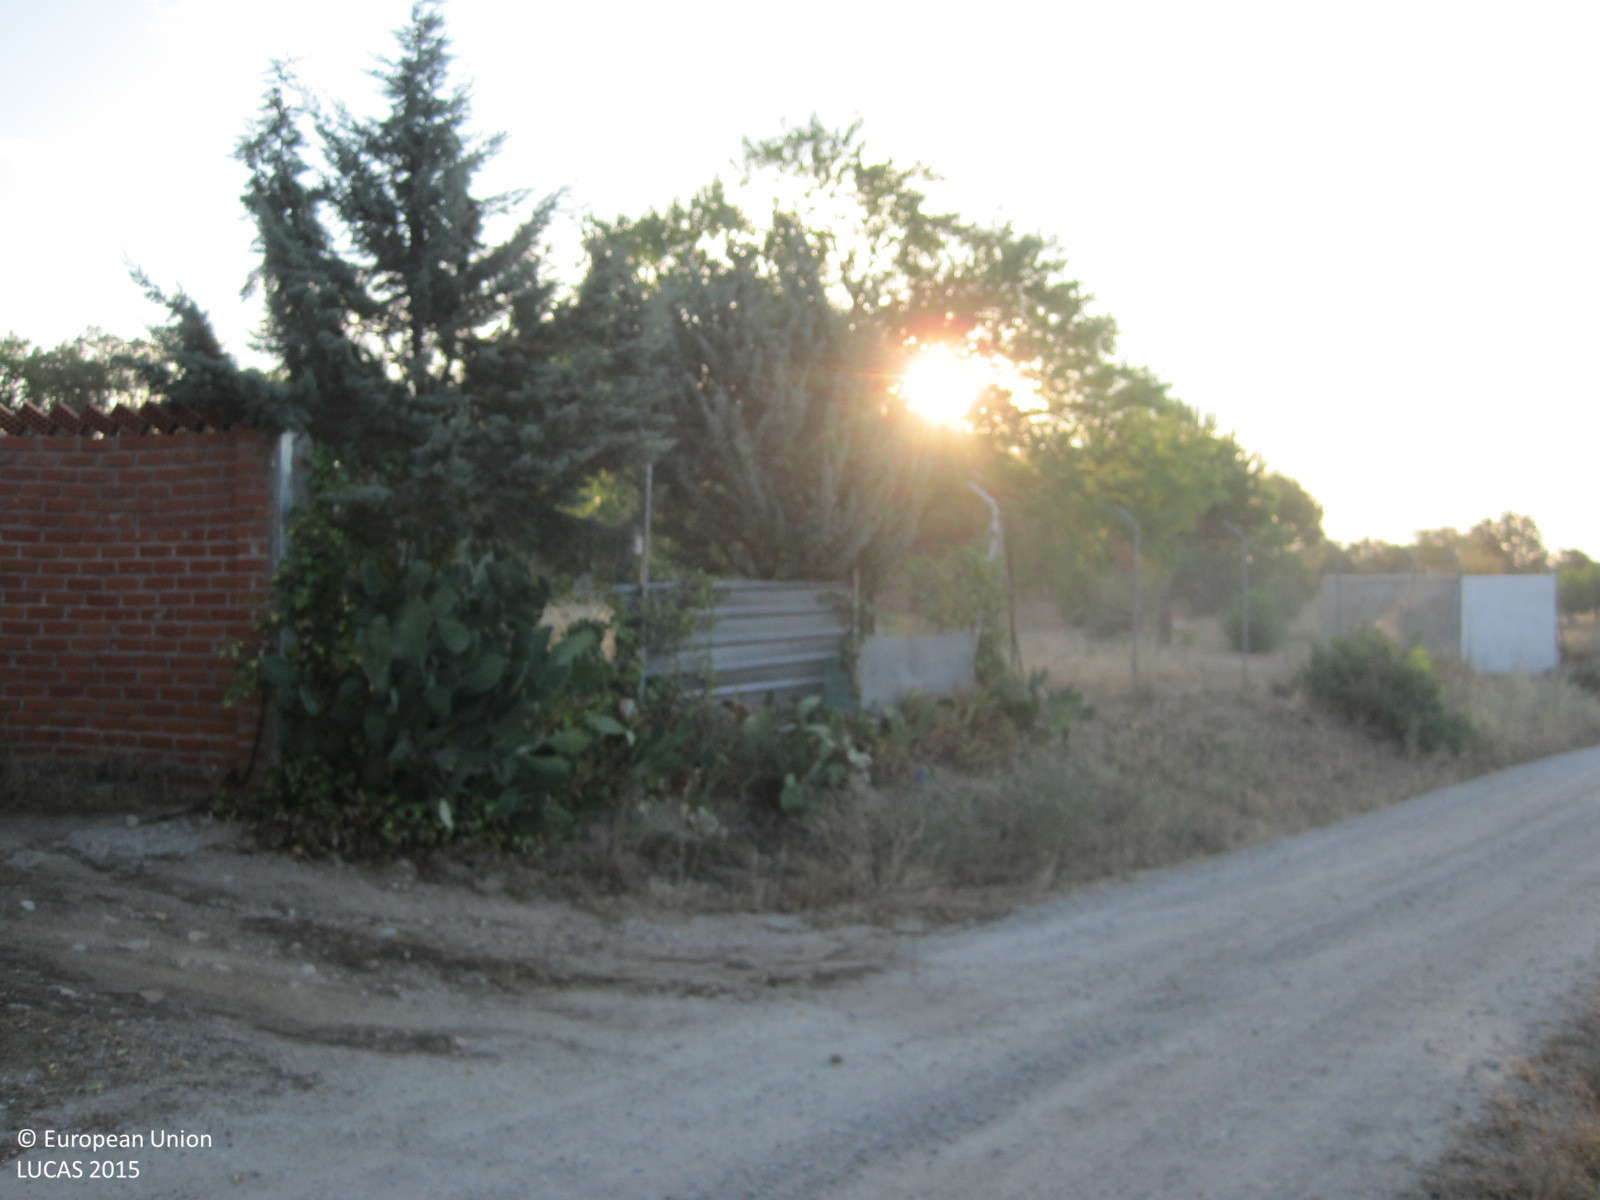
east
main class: Woodland
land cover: Pine dominated mixed woodland
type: coniferous forest of the mediterranean region
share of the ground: 50 - 75 %
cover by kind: coniferous forest trees 50 %, broadleaved forest trees 25 %, herbaceous plants 20 %, shrubs 5 %
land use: Semi-natural and natural areas not in use
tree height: > 5 m
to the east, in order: Pine dominated mixed woodland; Fences; Pine dominated coniferous woodland; Fences; Tracks; Pine dominated mixed woodland; Rock outcrops
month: July
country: ES
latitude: 40.3613
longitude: -4.3533
